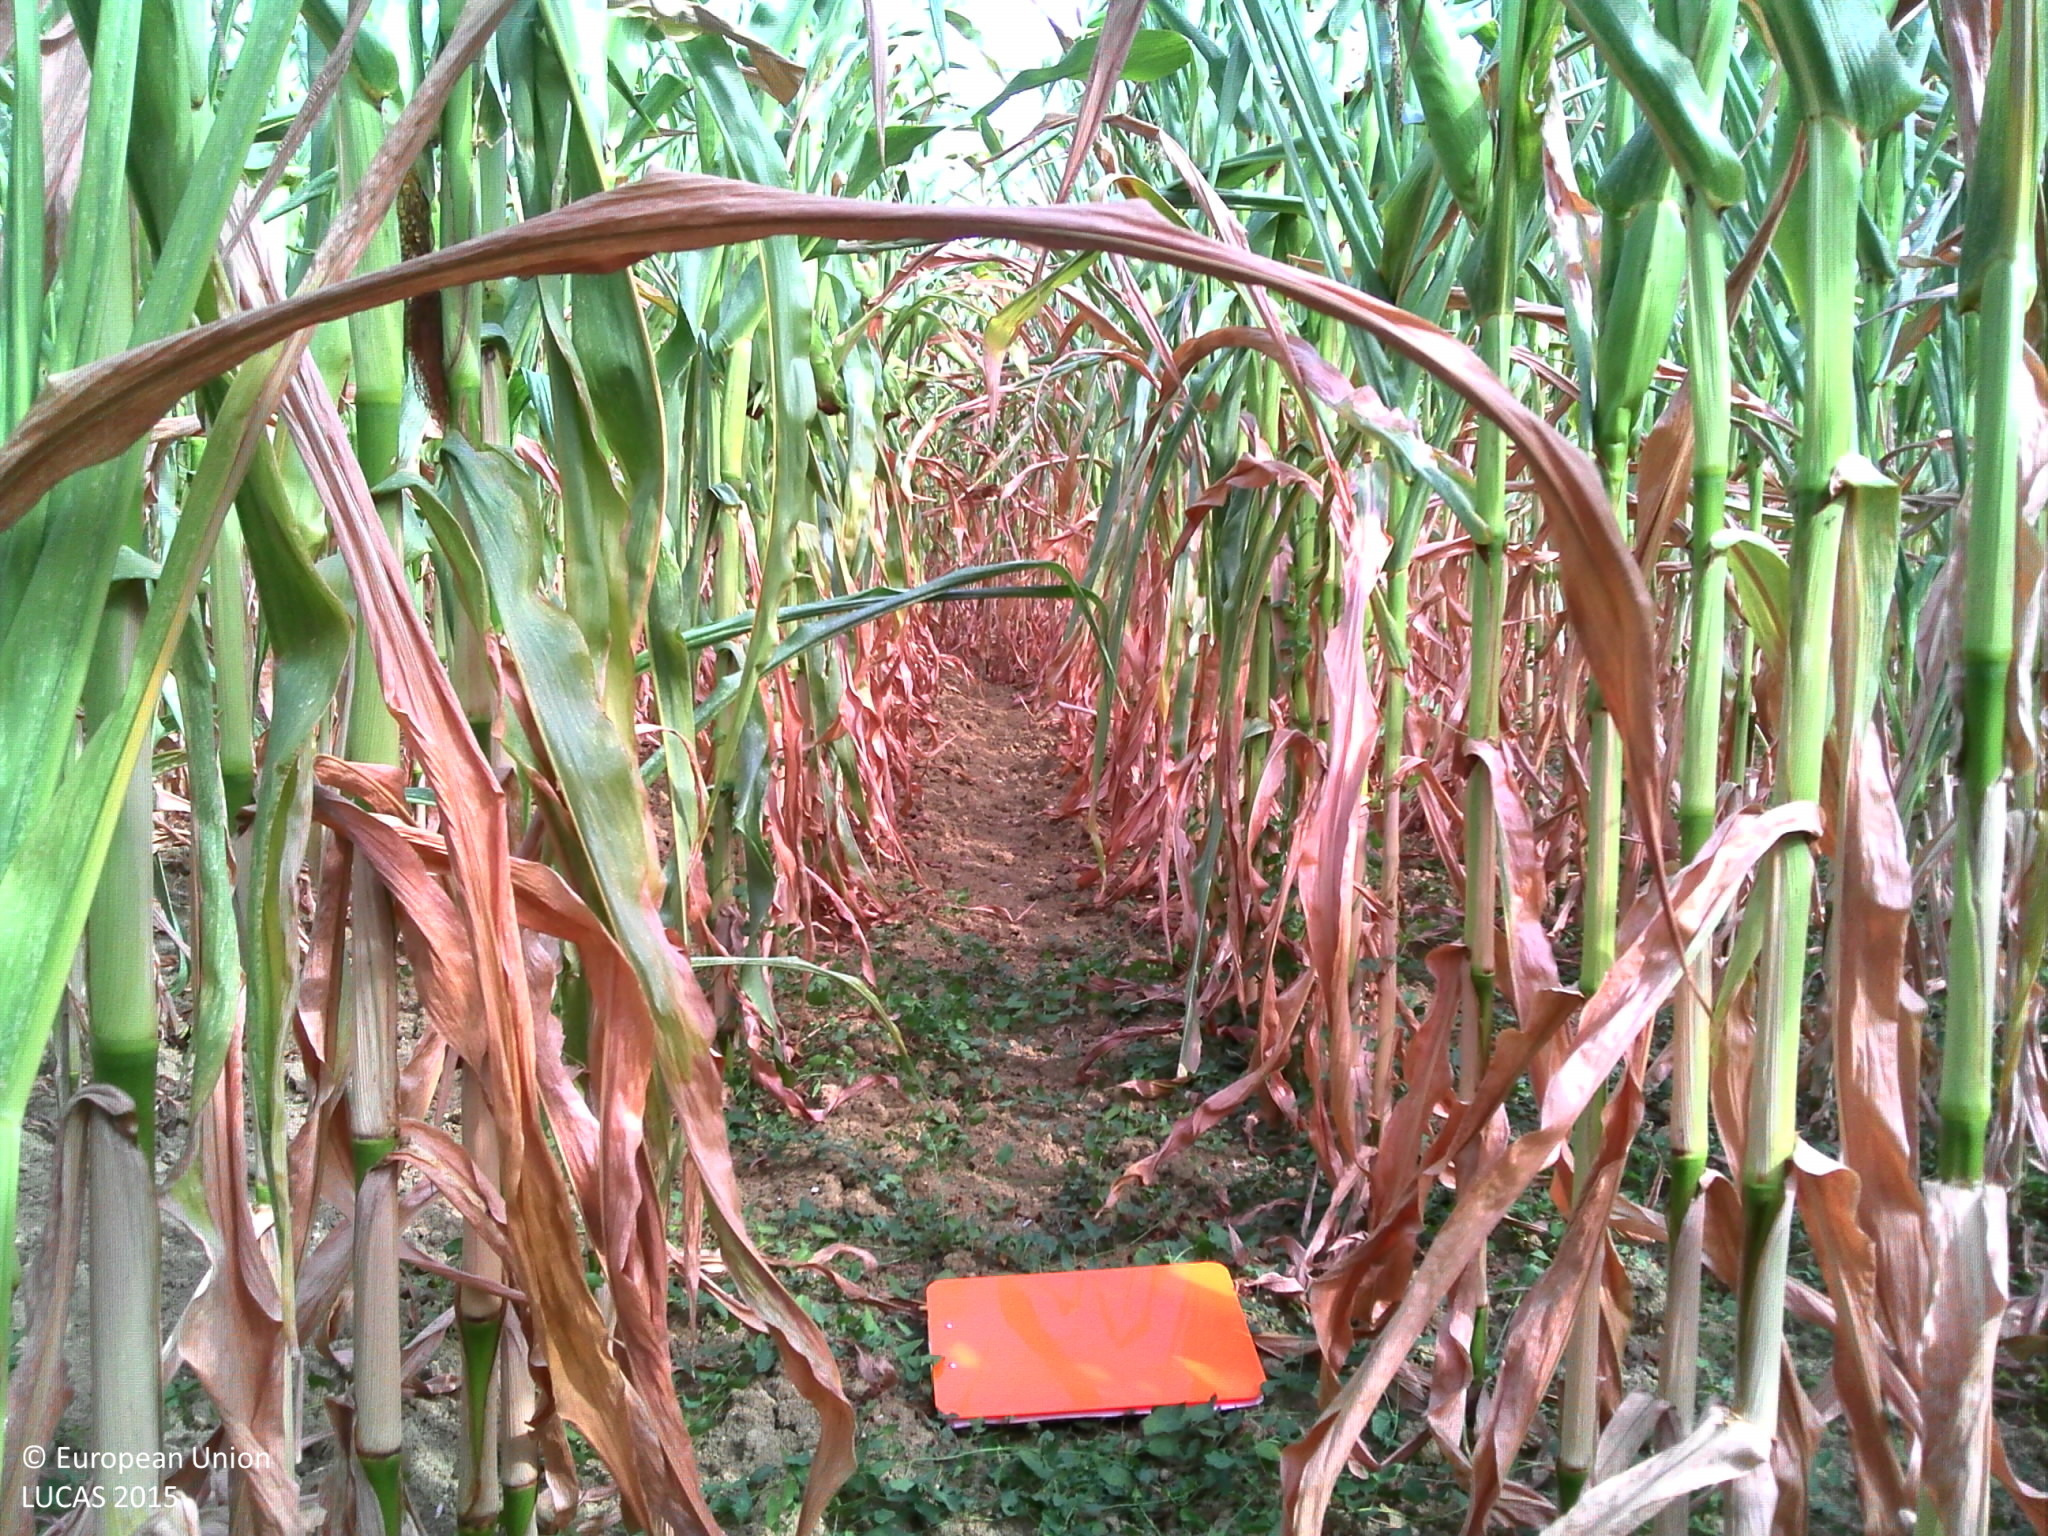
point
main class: Cropland
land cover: Maize
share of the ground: 50 - 75 %
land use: Agriculture (excluding fallow land and kitchen gardens)
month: August
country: FR
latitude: 44.5593
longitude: 0.6133
